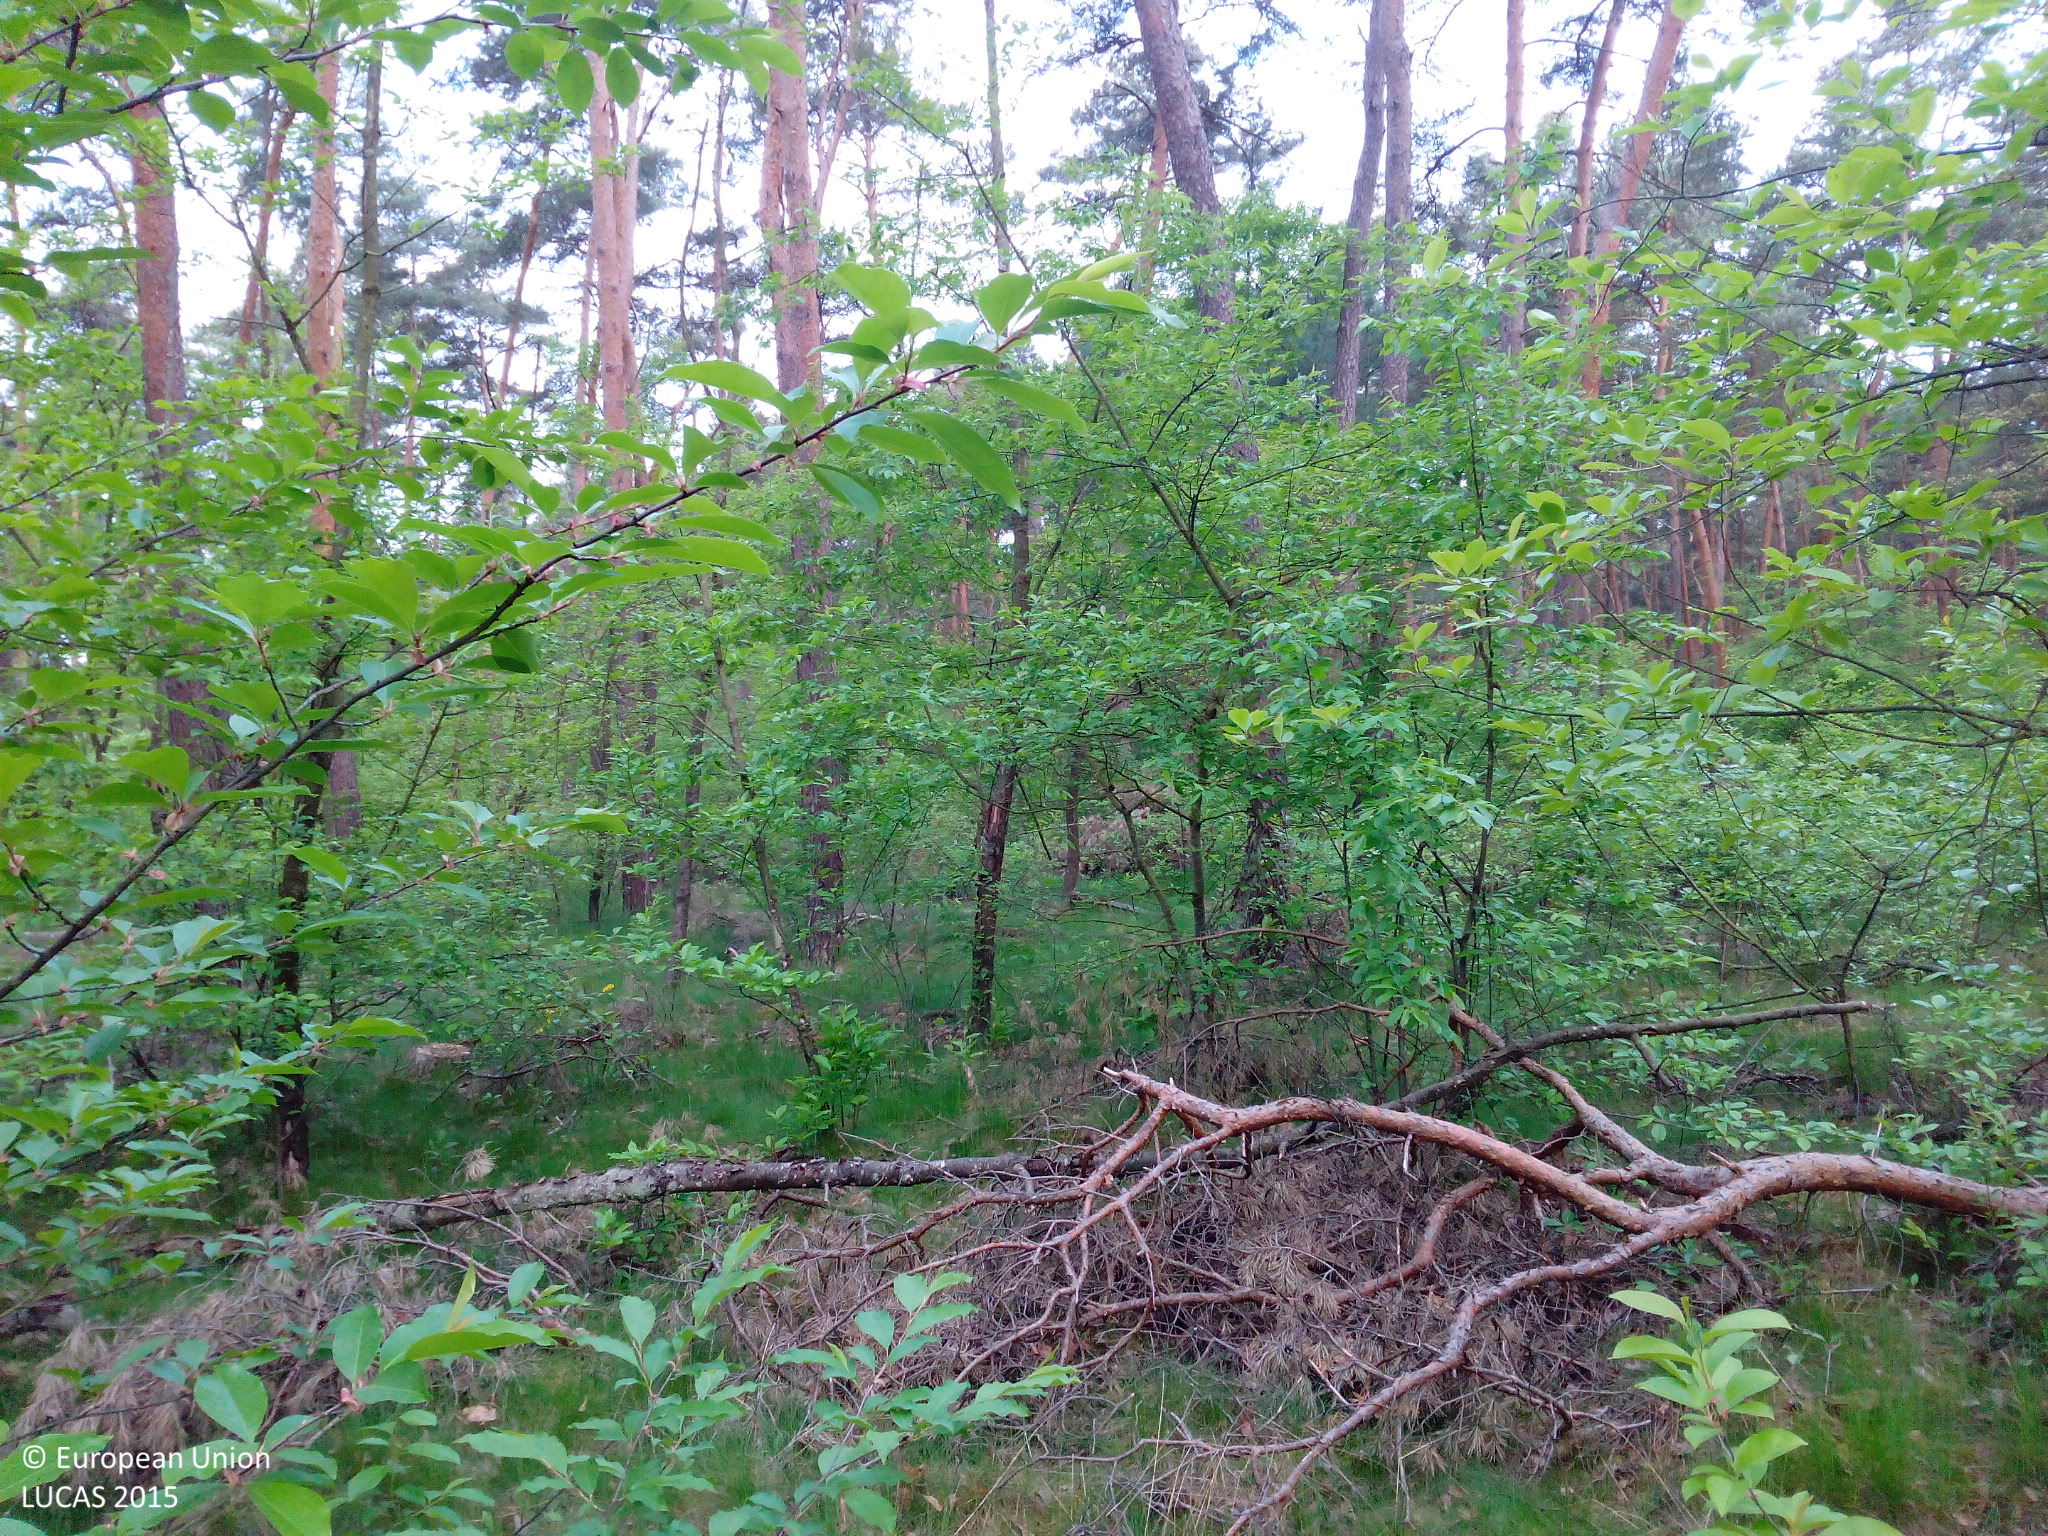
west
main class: Woodland
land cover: Pine dominated mixed woodland
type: hemiboreal forest and nemoral coniferous forest and mixed broadleaved-coniferous forest
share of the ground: 50 - 75 %
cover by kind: coniferous forest trees 45 %, broadleaved forest trees 25 %, herbaceous plants 25 %, shrubs 5 %
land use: Forestry
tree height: > 5 m
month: May
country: DE
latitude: 49.6170
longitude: 8.5194
